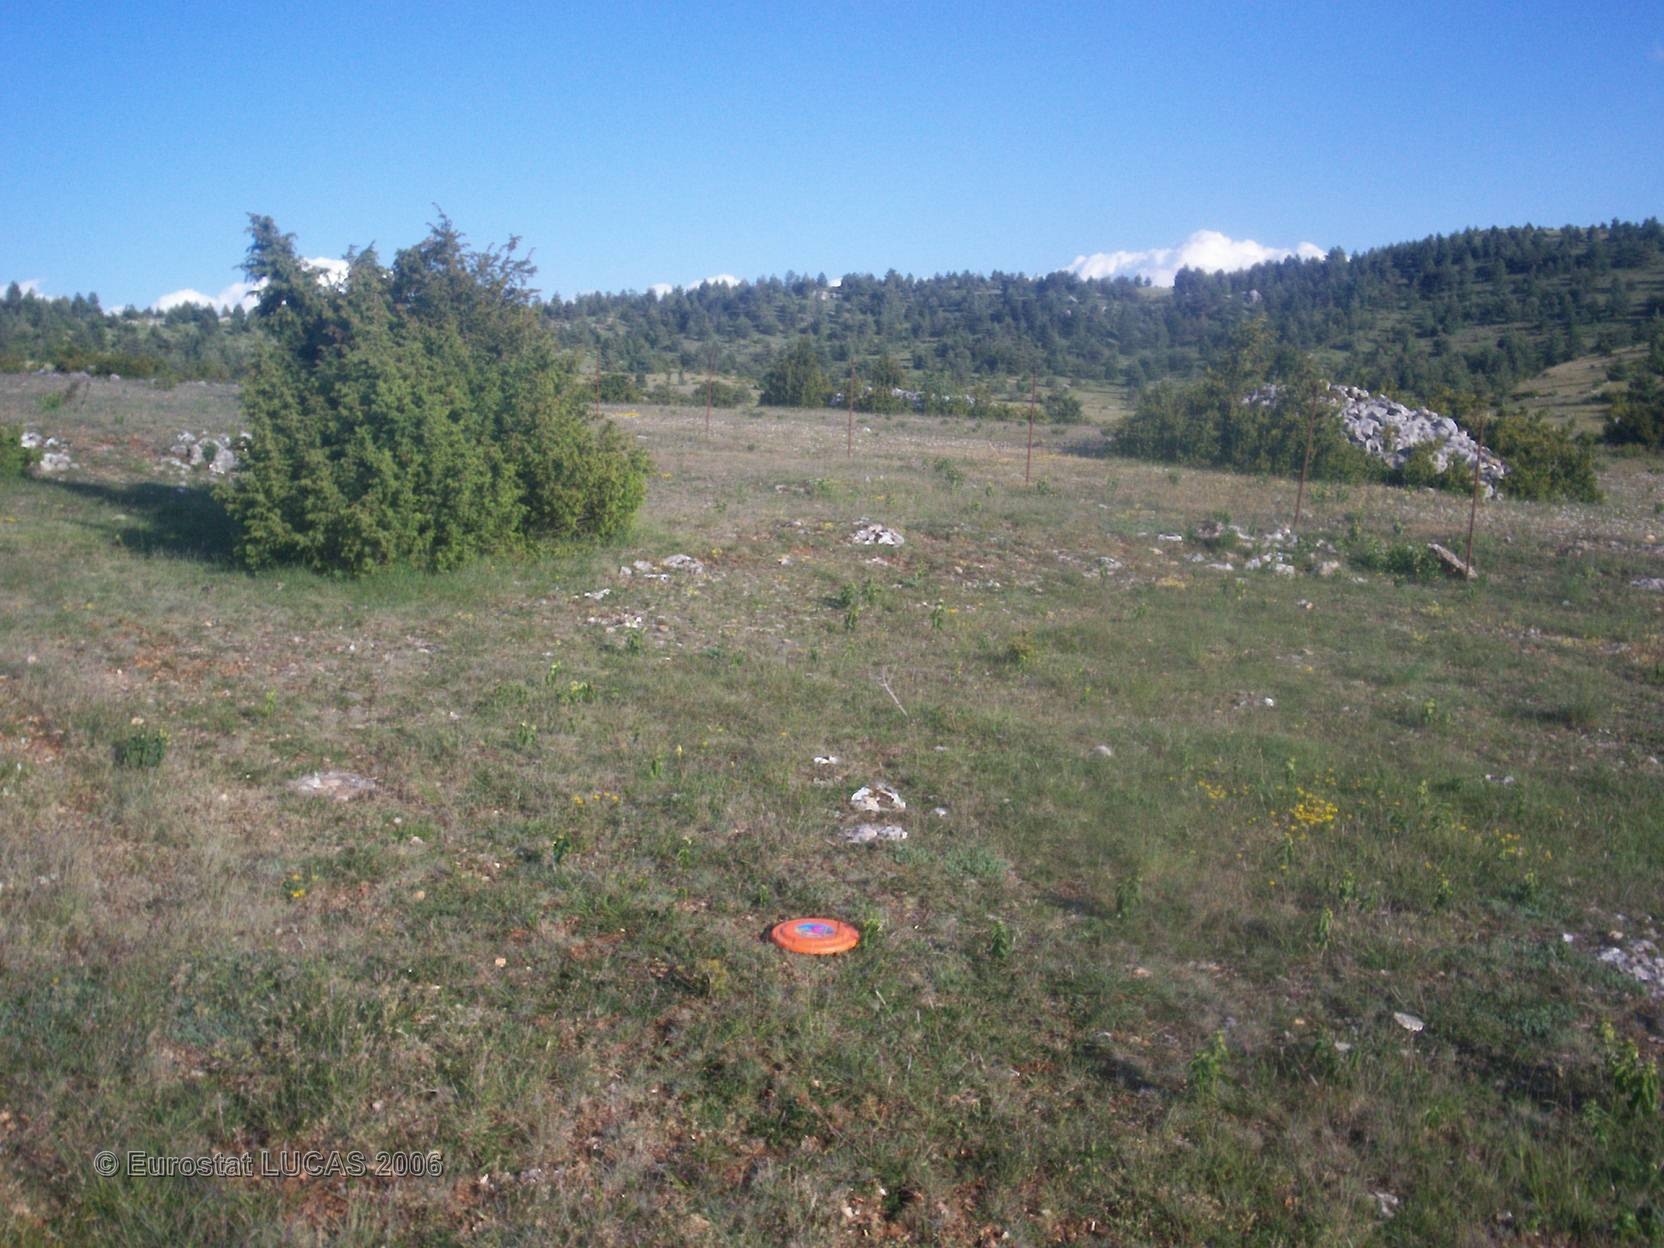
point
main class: Grassland
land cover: Grassland without tree/shrub cover
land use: Agriculture (excluding fallow land and kitchen gardens)
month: June
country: FR
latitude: 44.3243
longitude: 3.4477
